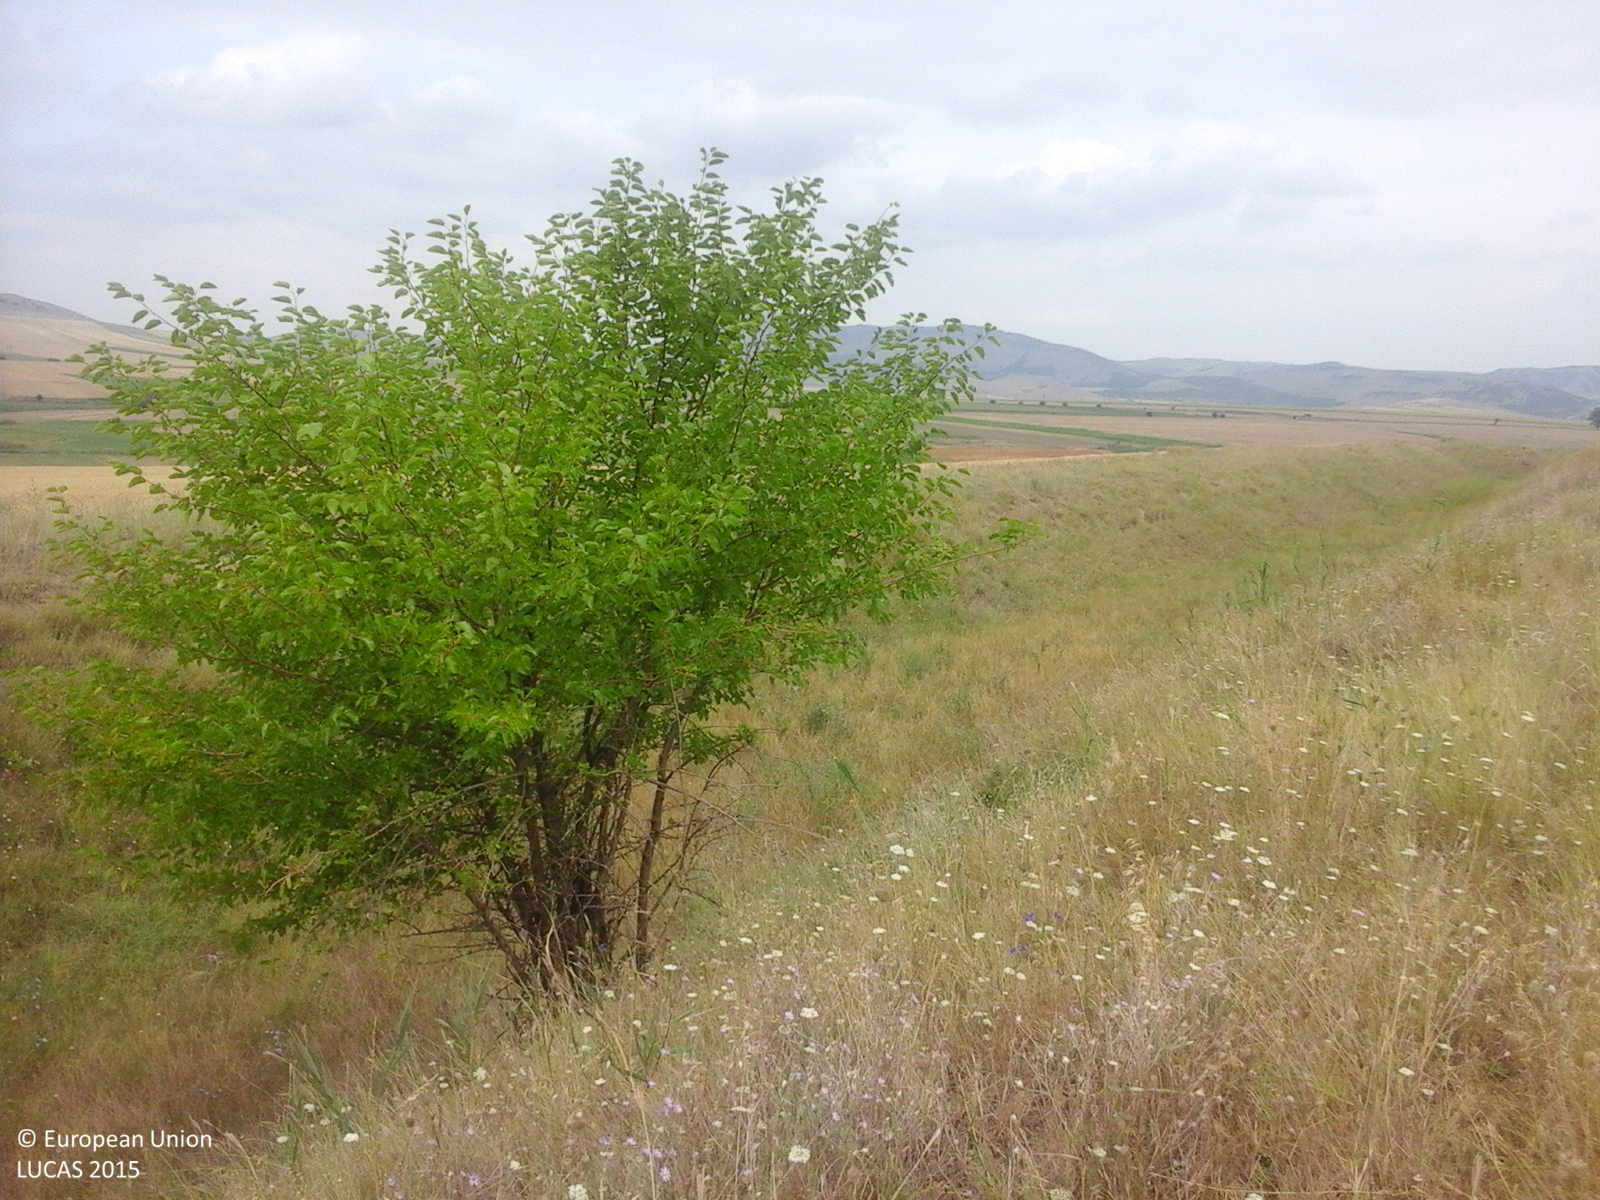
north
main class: Grassland
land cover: Grassland without tree/shrub cover
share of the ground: > 75 %
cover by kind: herbaceous plants 100 %
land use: Agriculture (excluding fallow land and kitchen gardens)
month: July
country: RO
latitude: 45.0558
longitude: 28.2676
